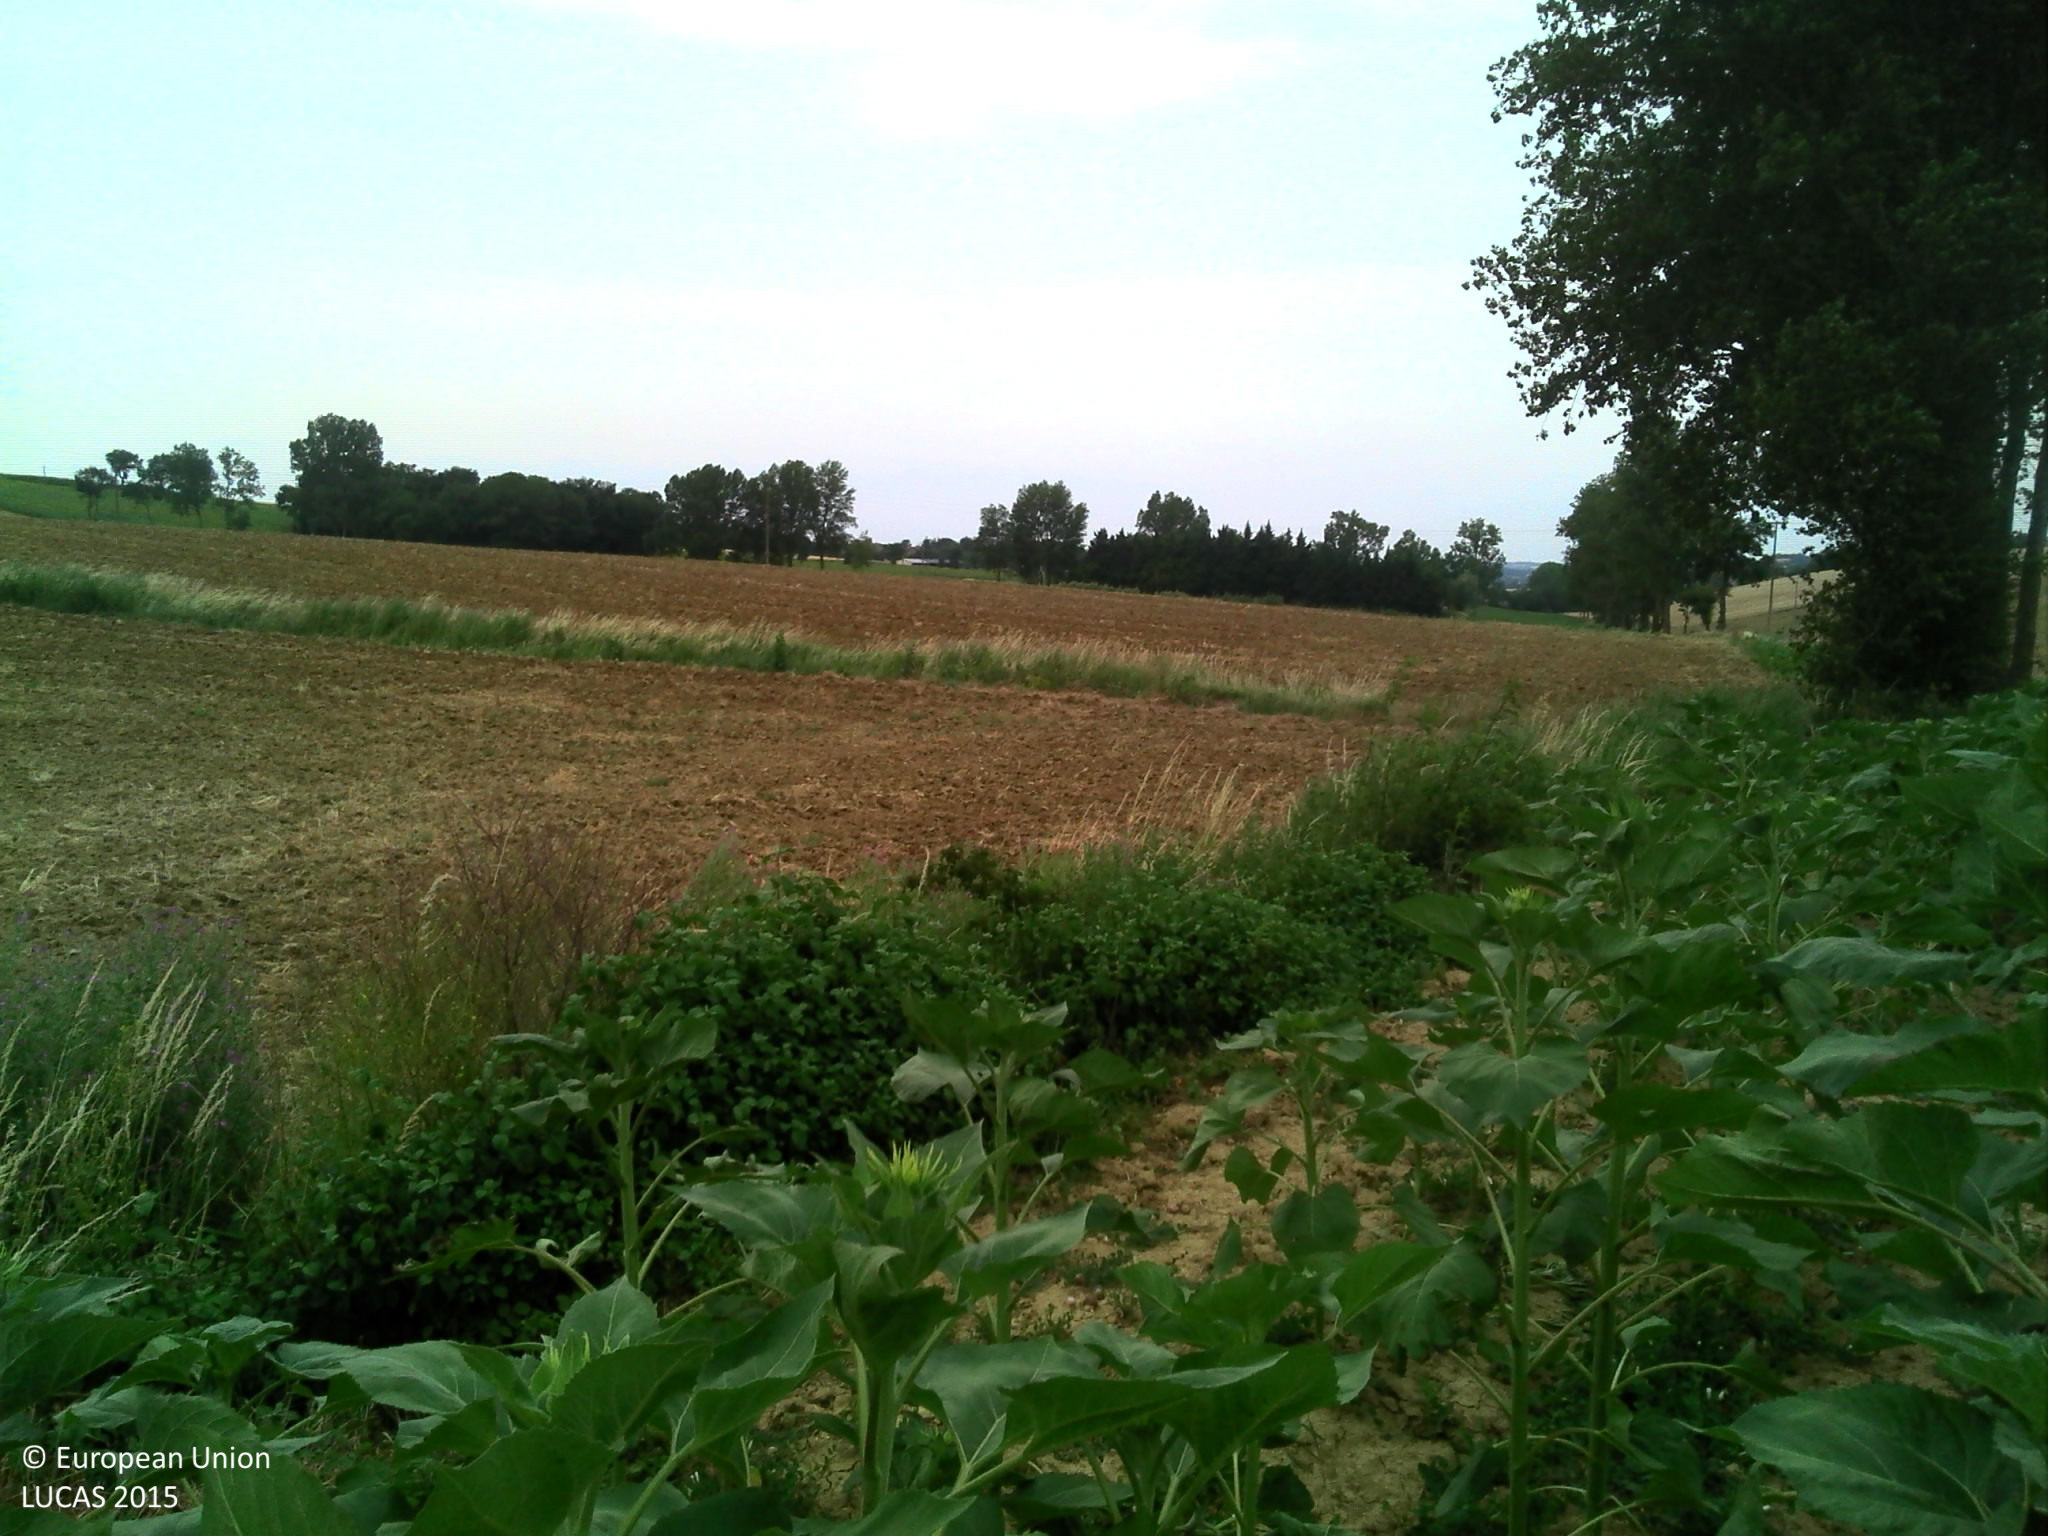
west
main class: Cropland
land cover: Sunflower
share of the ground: > 75 %
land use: Agriculture (excluding fallow land and kitchen gardens)
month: July
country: FR
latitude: 43.4785
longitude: 1.7584
